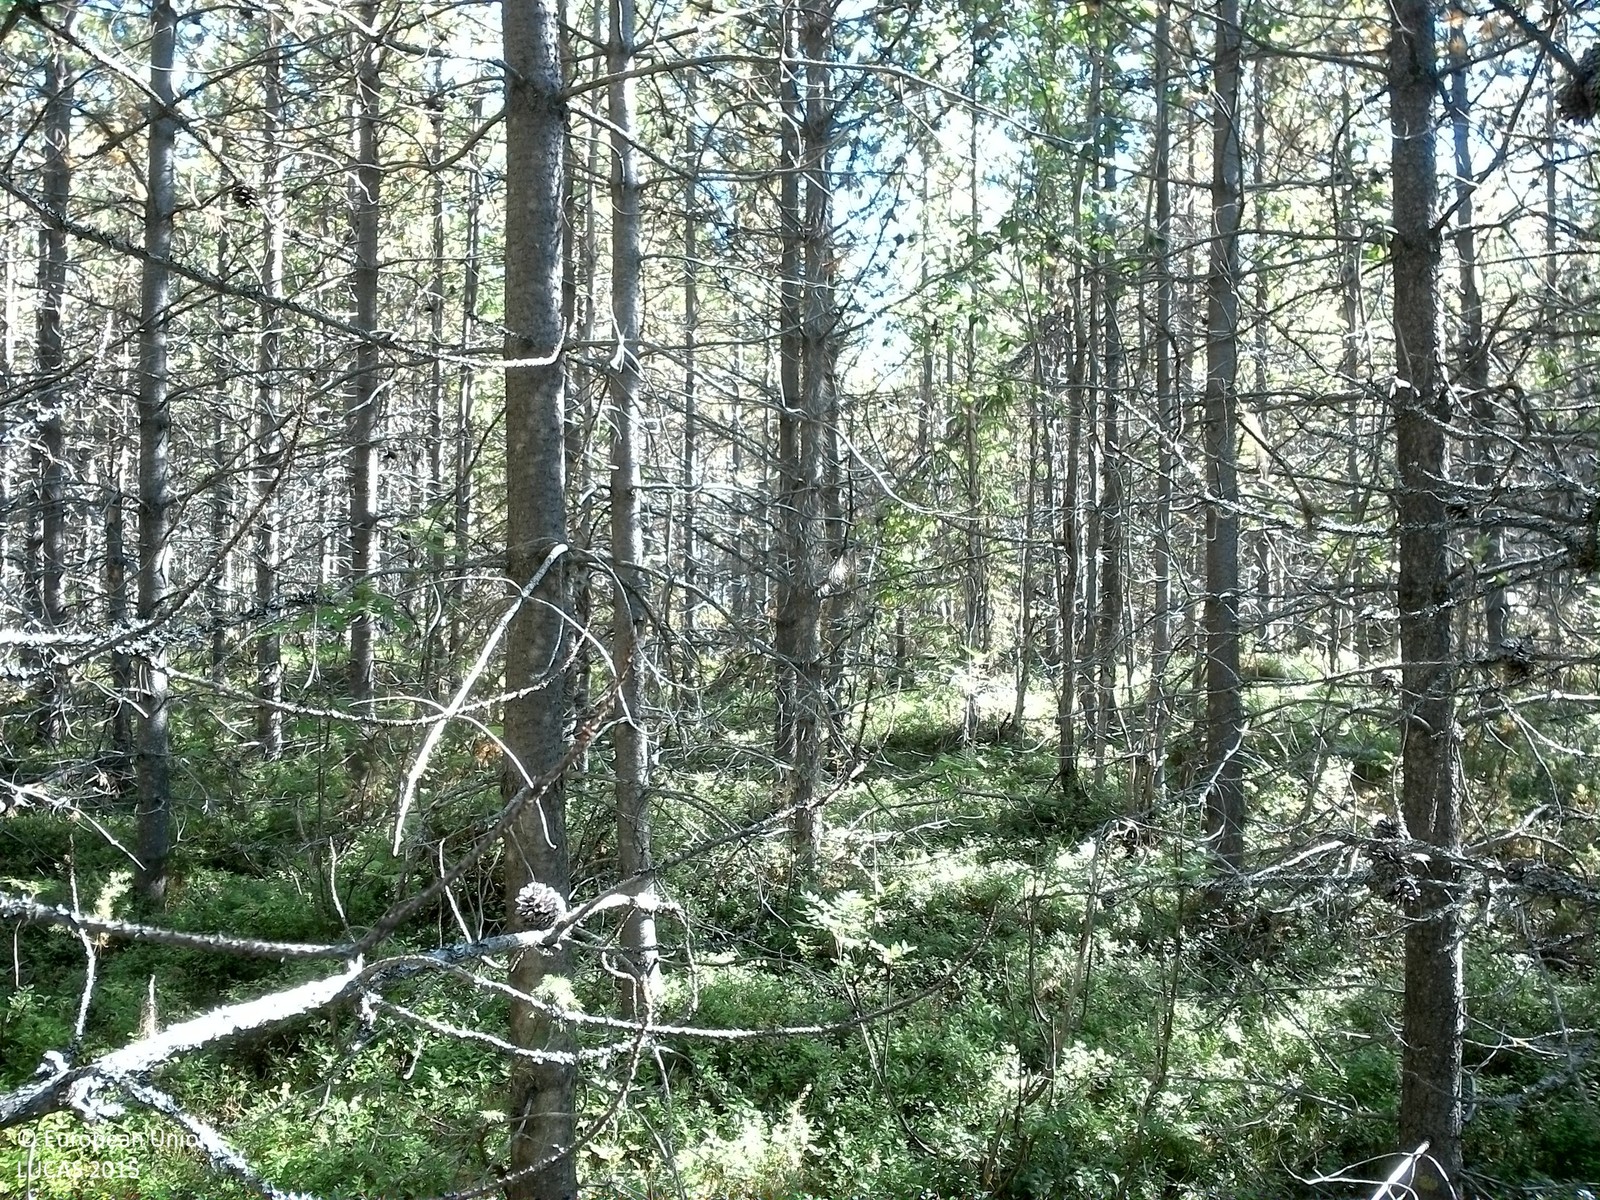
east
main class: Woodland
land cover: Pine dominated coniferous woodland
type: exotic forest
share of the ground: > 75 %
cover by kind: coniferous forest trees 80 %, shrubs 20 %
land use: Forestry
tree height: > 5 m
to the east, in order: Pine dominated coniferous woodland
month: August
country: SE
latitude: 63.9267
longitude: 17.5776
